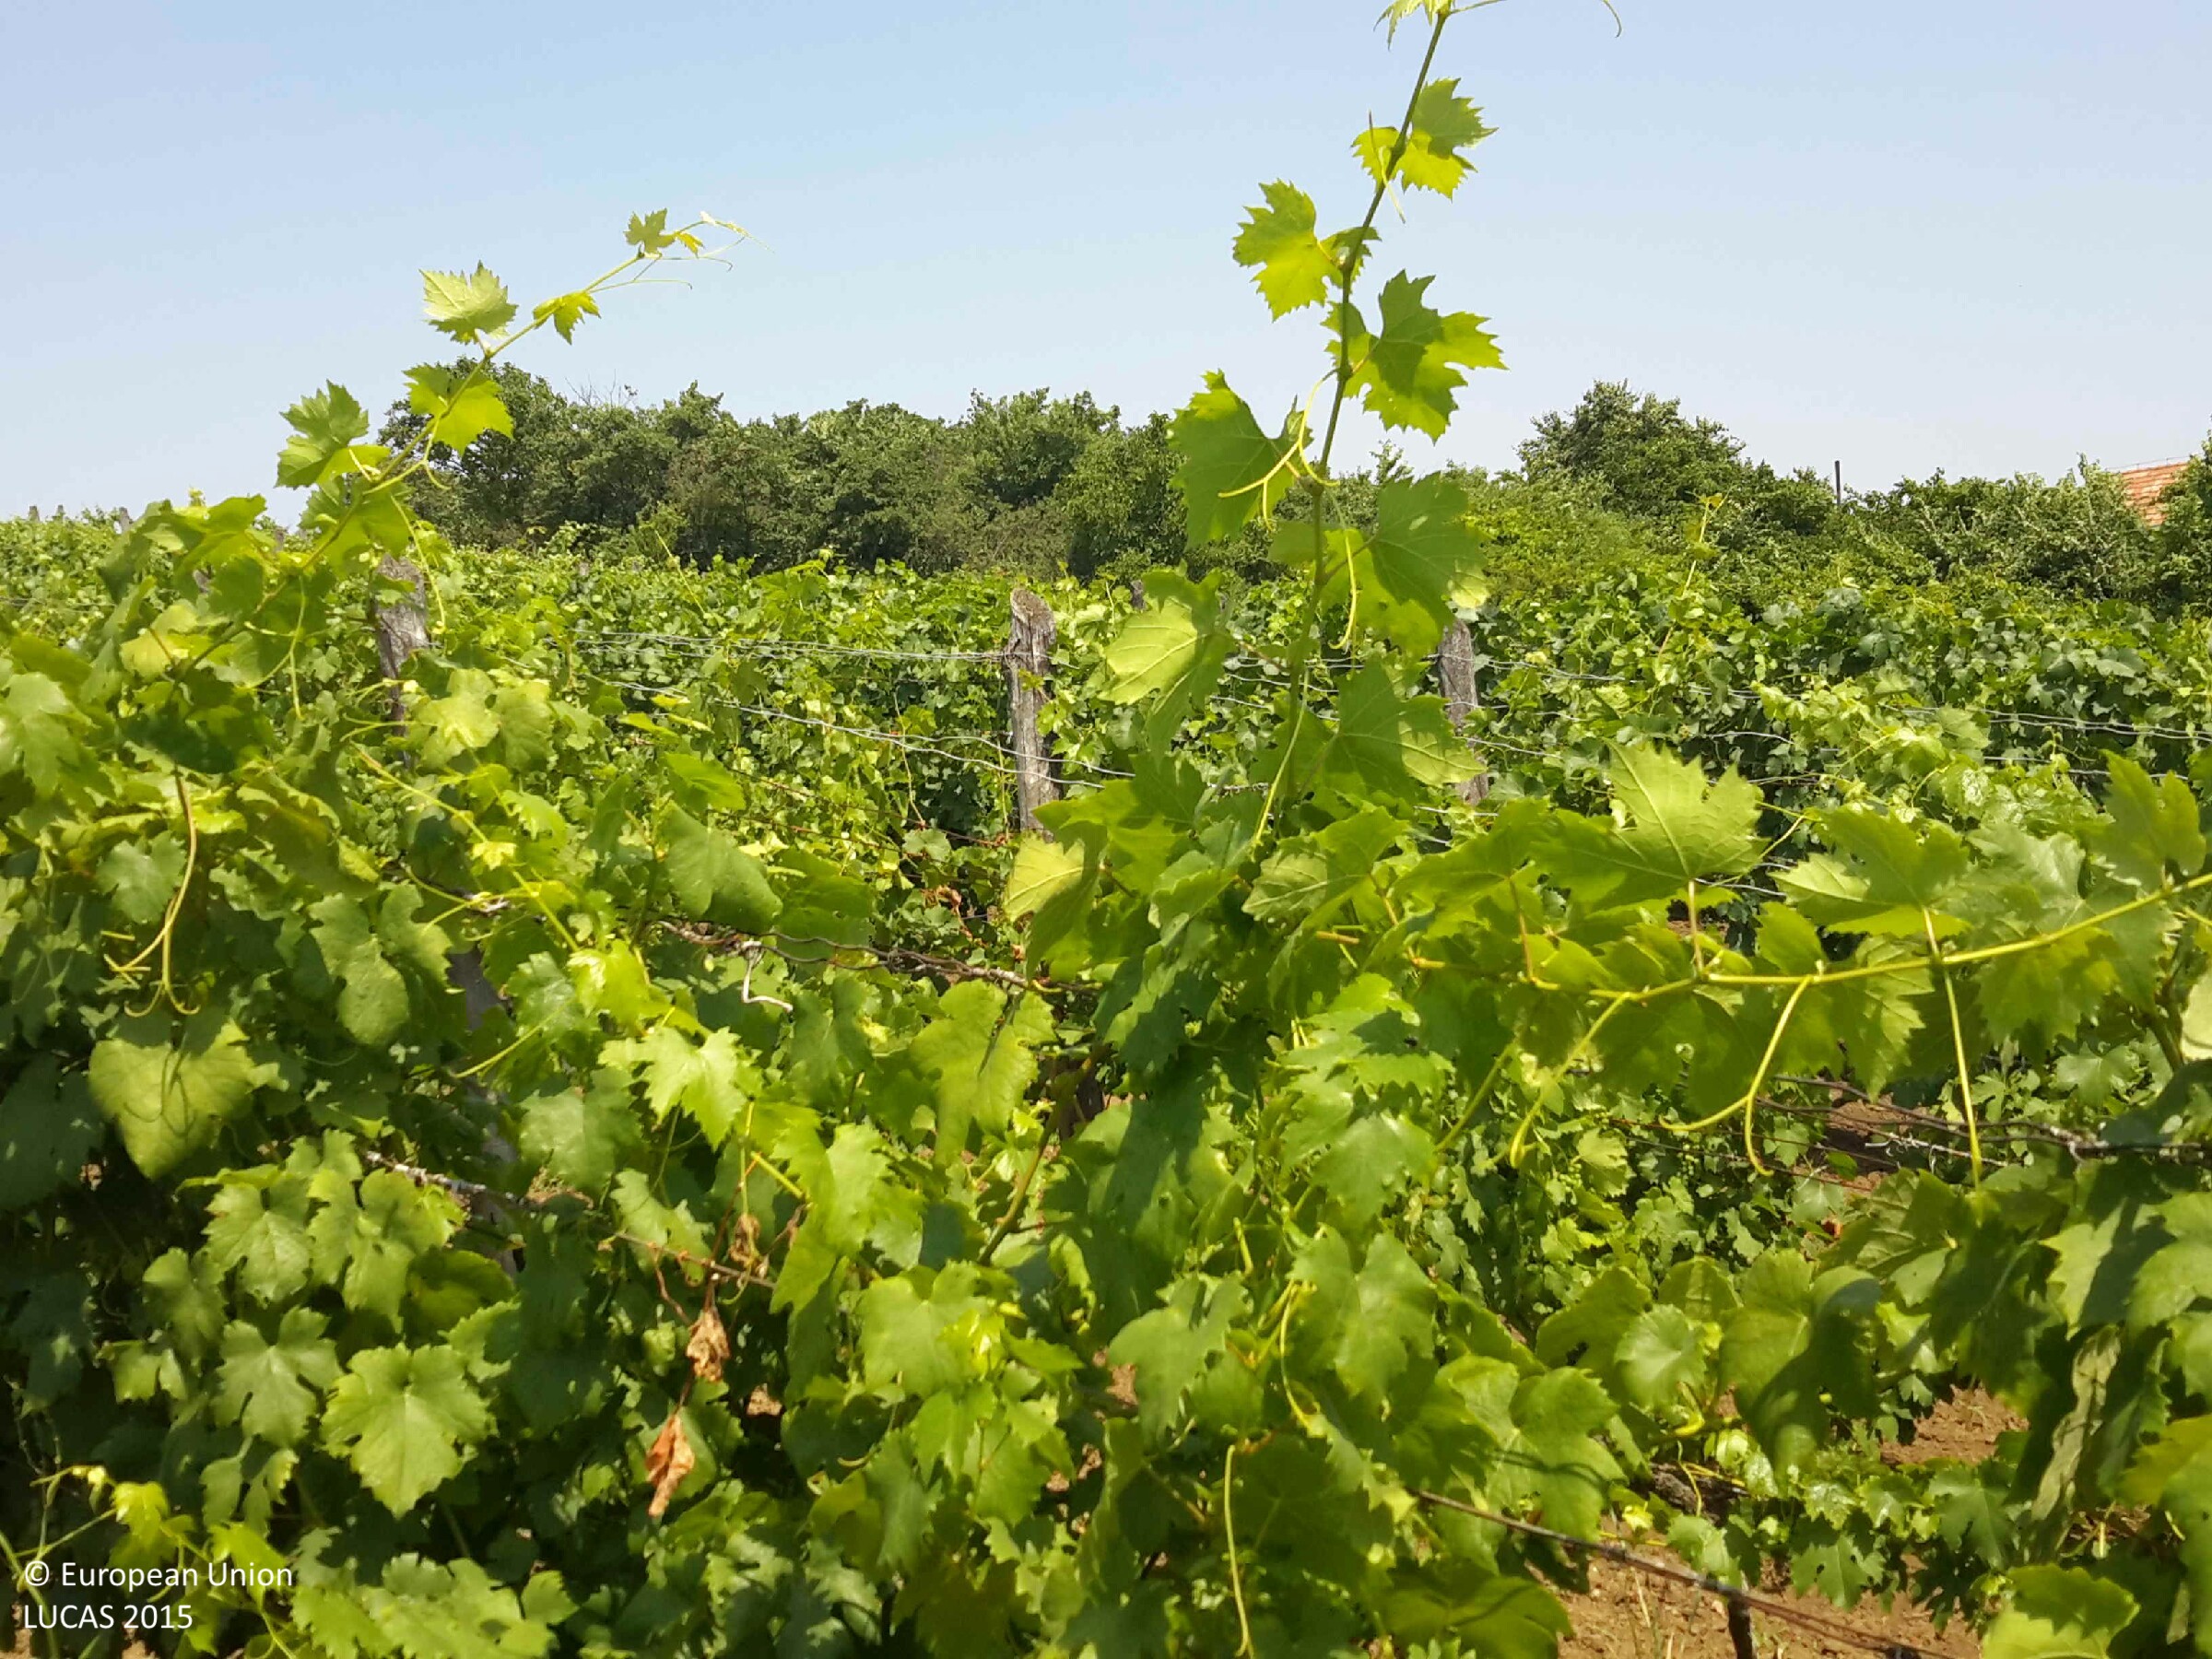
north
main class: Cropland
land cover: Vineyards
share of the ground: 25 - 50 %
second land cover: Other bare soil
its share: > 75 %
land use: Agriculture (excluding fallow land and kitchen gardens)
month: July
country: HU
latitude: 47.2213
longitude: 17.0438
